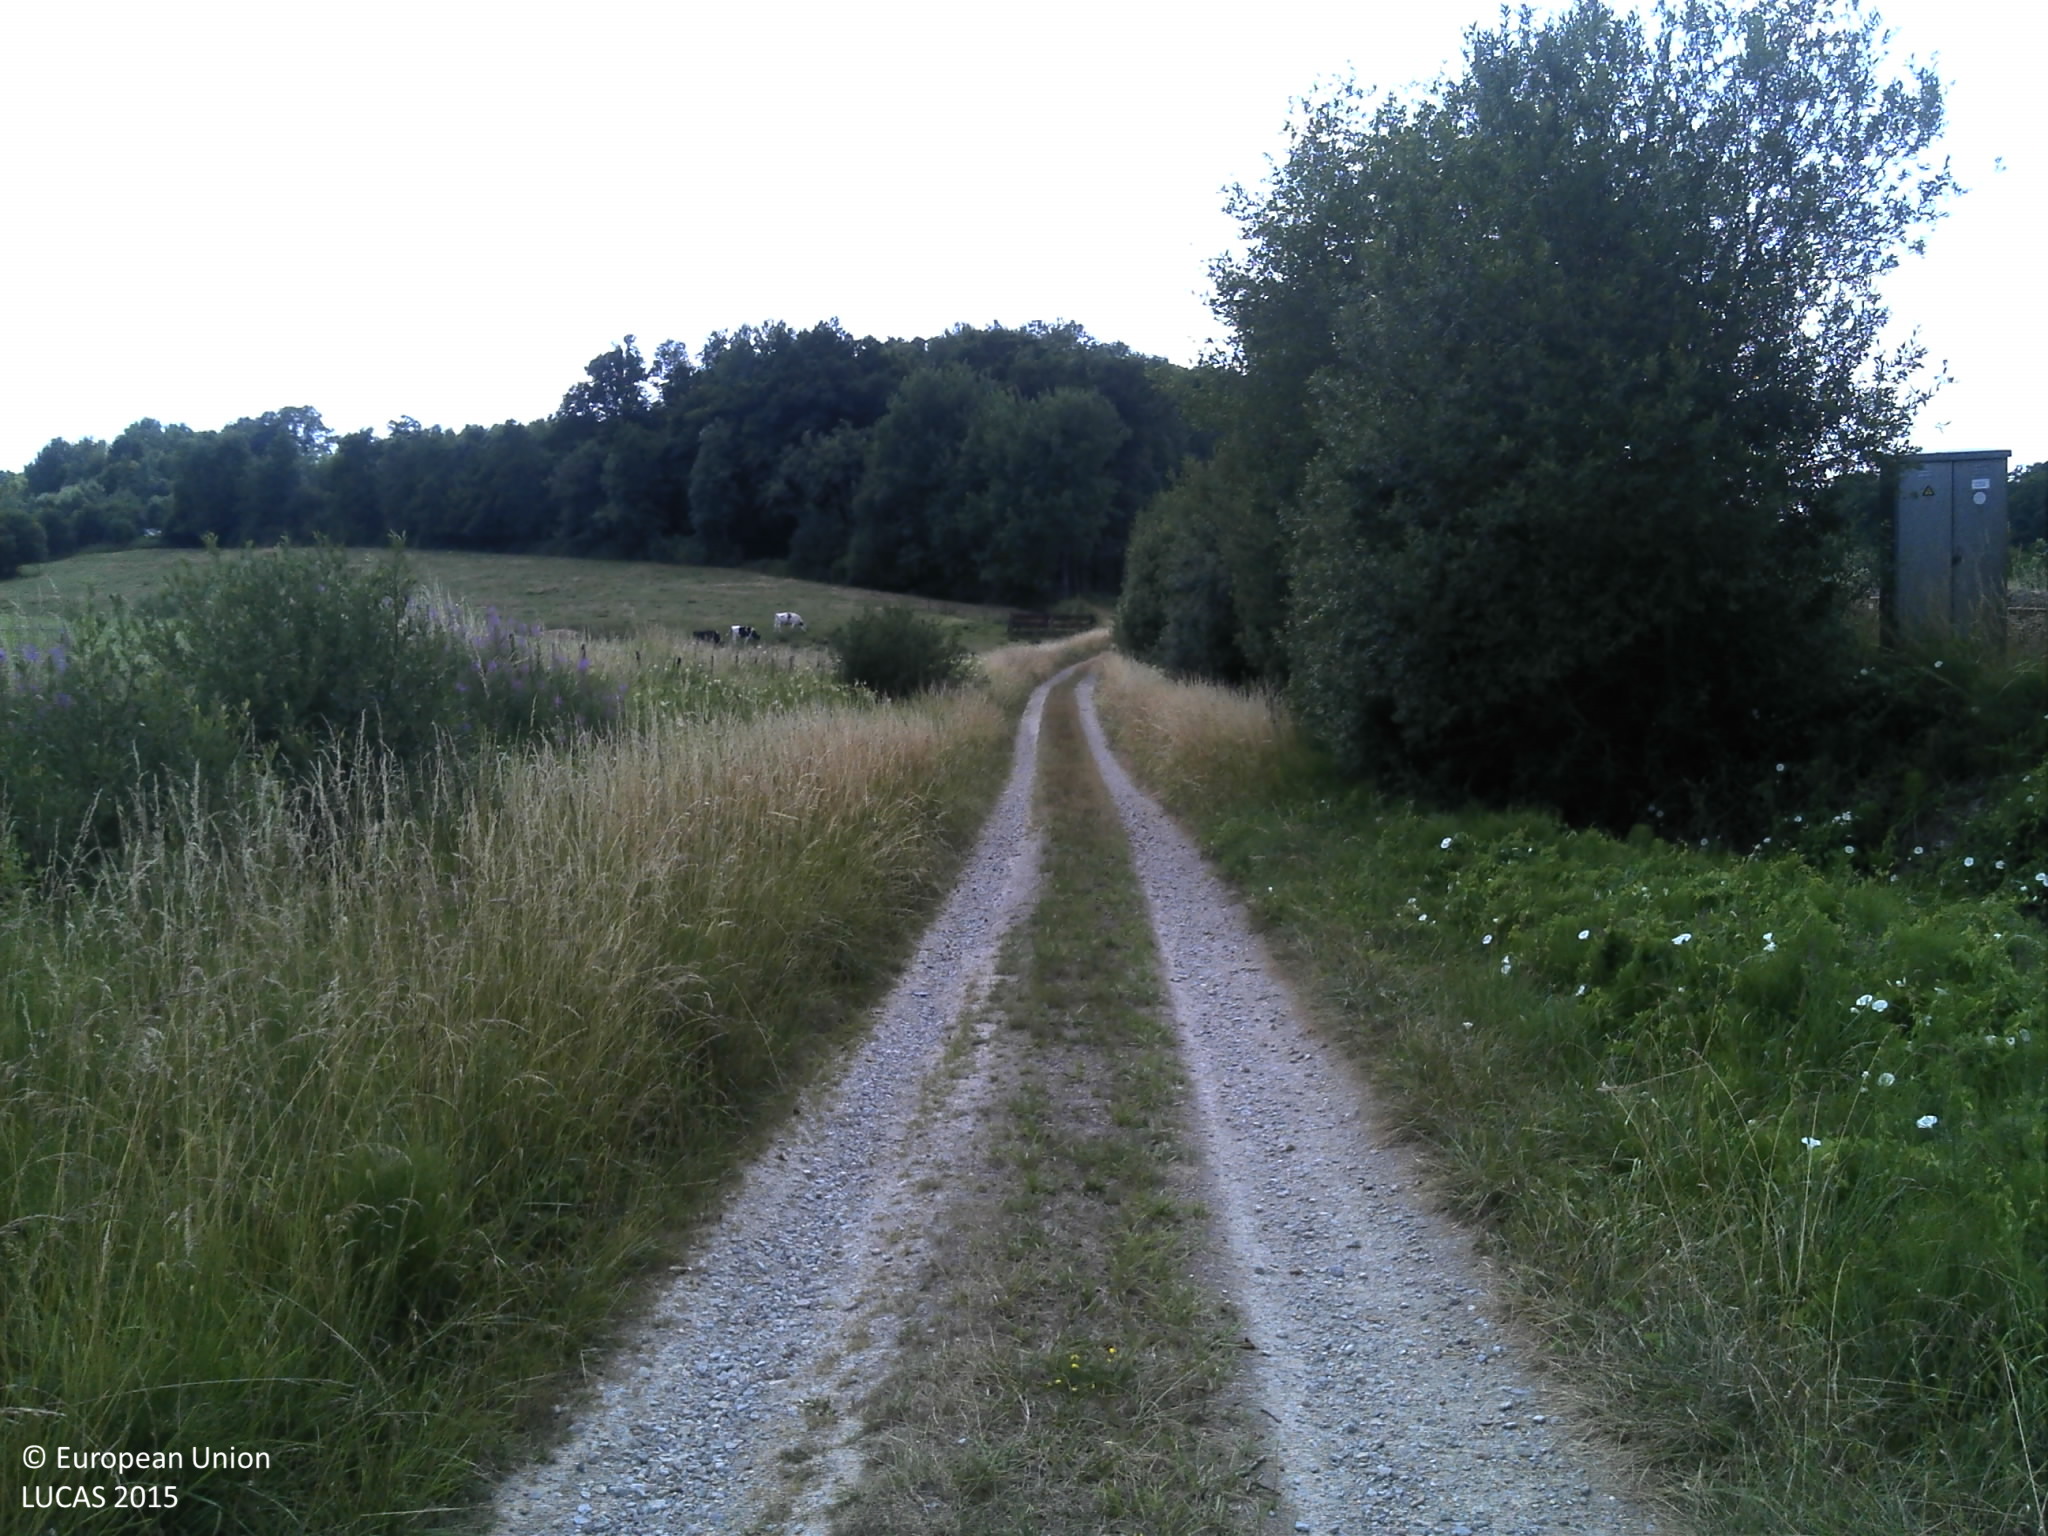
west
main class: Artificial land
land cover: Non built-up linear features
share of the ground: > 75 %
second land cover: Spontaneously vegetated surfaces
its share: 25 - 50 %
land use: Road transport
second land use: Agriculture (excluding fallow land and kitchen gardens)
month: July
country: FR
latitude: 49.6422
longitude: 4.6095
